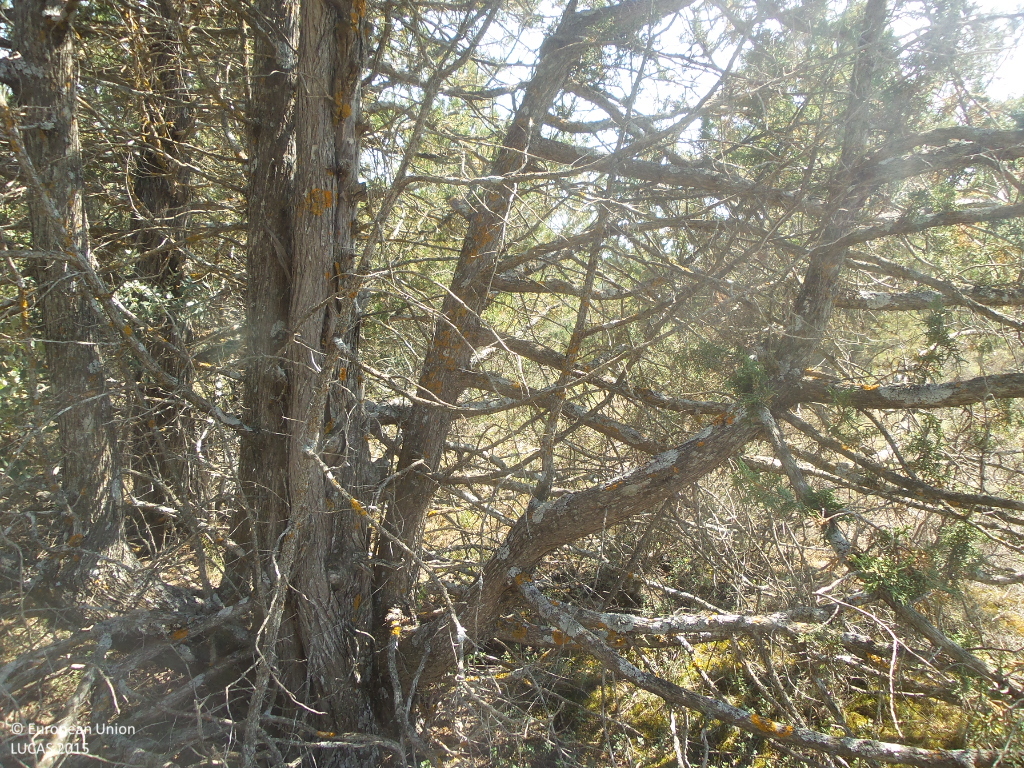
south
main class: Woodland
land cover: Other coniferous woodland
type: coniferous forest of the mediterranean region
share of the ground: 50 - 75 %
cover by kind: coniferous forest trees 50 %, shrubs 35 %, herbaceous plants 10 %, lichens and mosses 5 %
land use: Semi-natural and natural areas not in use
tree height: > 5 m
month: July
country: ES
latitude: 41.0909
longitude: -2.0623
